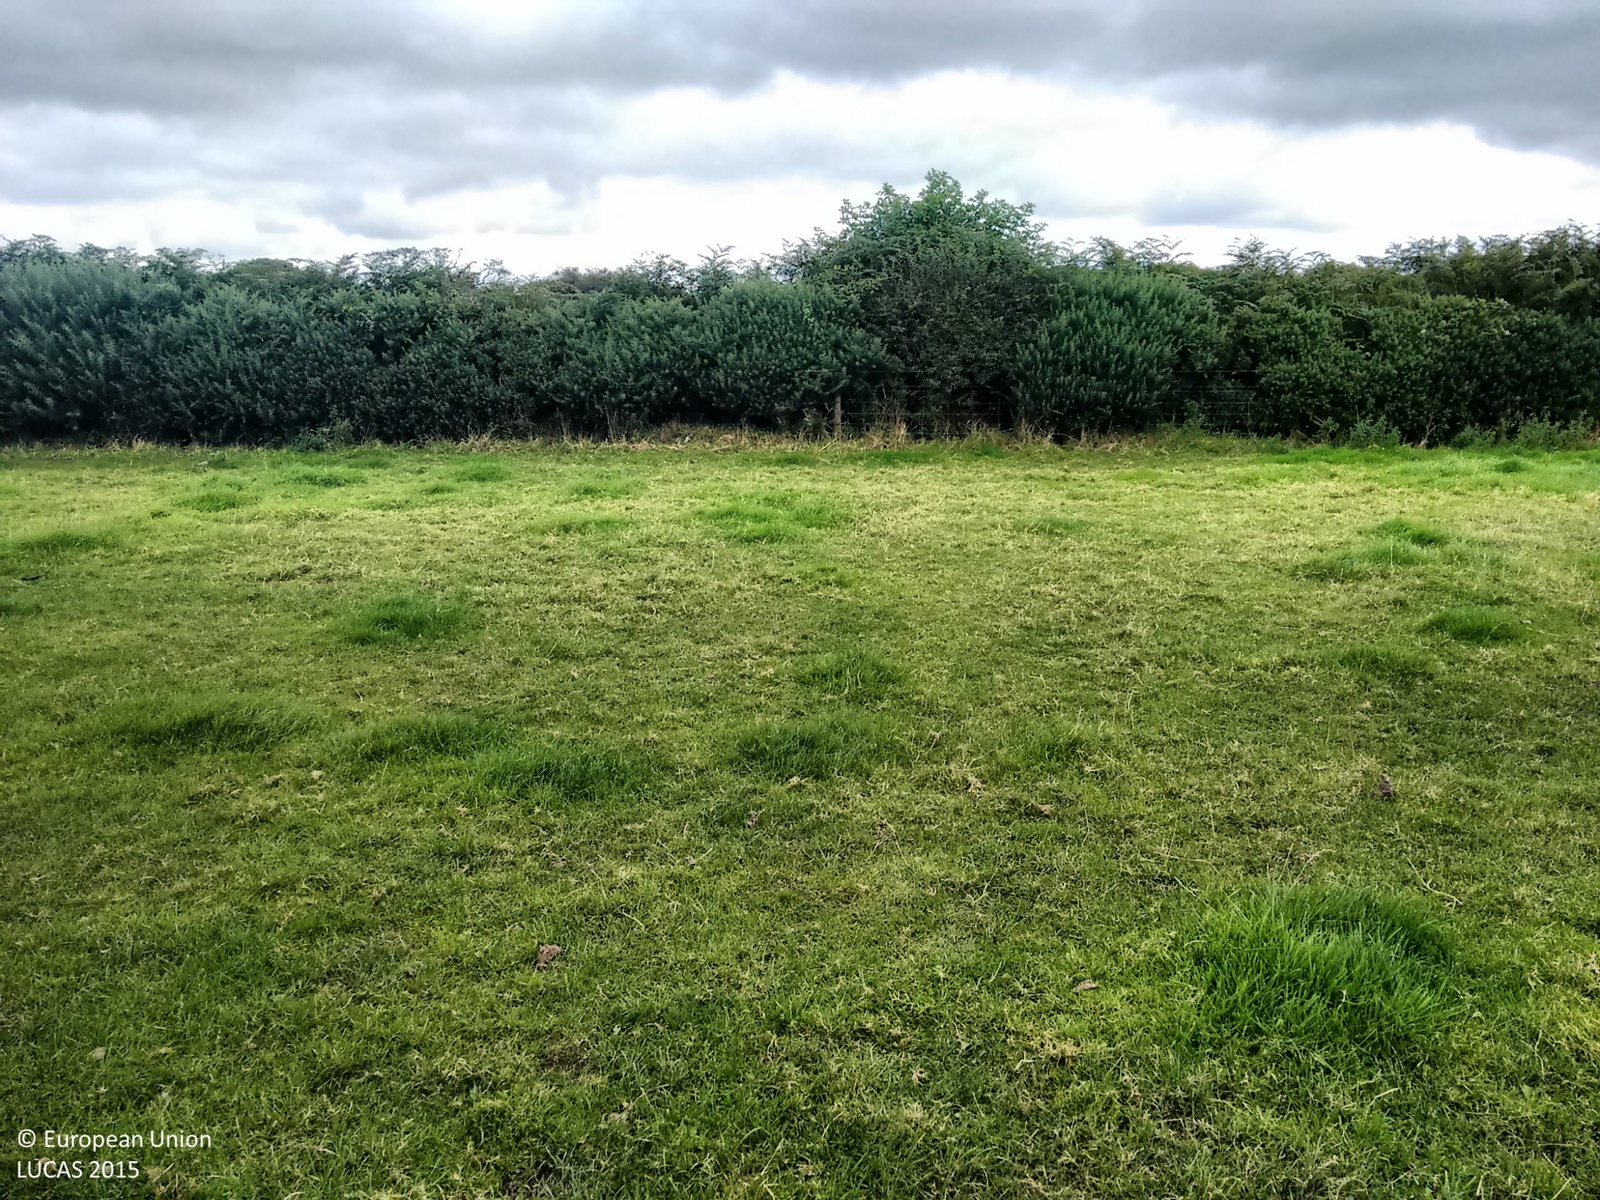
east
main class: Grassland
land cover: Grassland without tree/shrub cover
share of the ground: > 75 %
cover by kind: herbaceous plants 100 %
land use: Agriculture (excluding fallow land and kitchen gardens)
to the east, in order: Grassland without tree/shrub cover; Fences; Managed hedges; Artificial constructions; Fences; Grassland without tree/shrub cover; Fences; Managed hedges; Artificial constructions; Fences; Grassland without tree/shrub cover; Fences; Broadleaved woodland; Electric lines; Artificial constructions; Paved roads, cycling and walking lanes; Broadleaved woodland; Grassland without tree/shrub cover
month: September
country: GB
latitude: 50.5925
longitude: -4.4411
